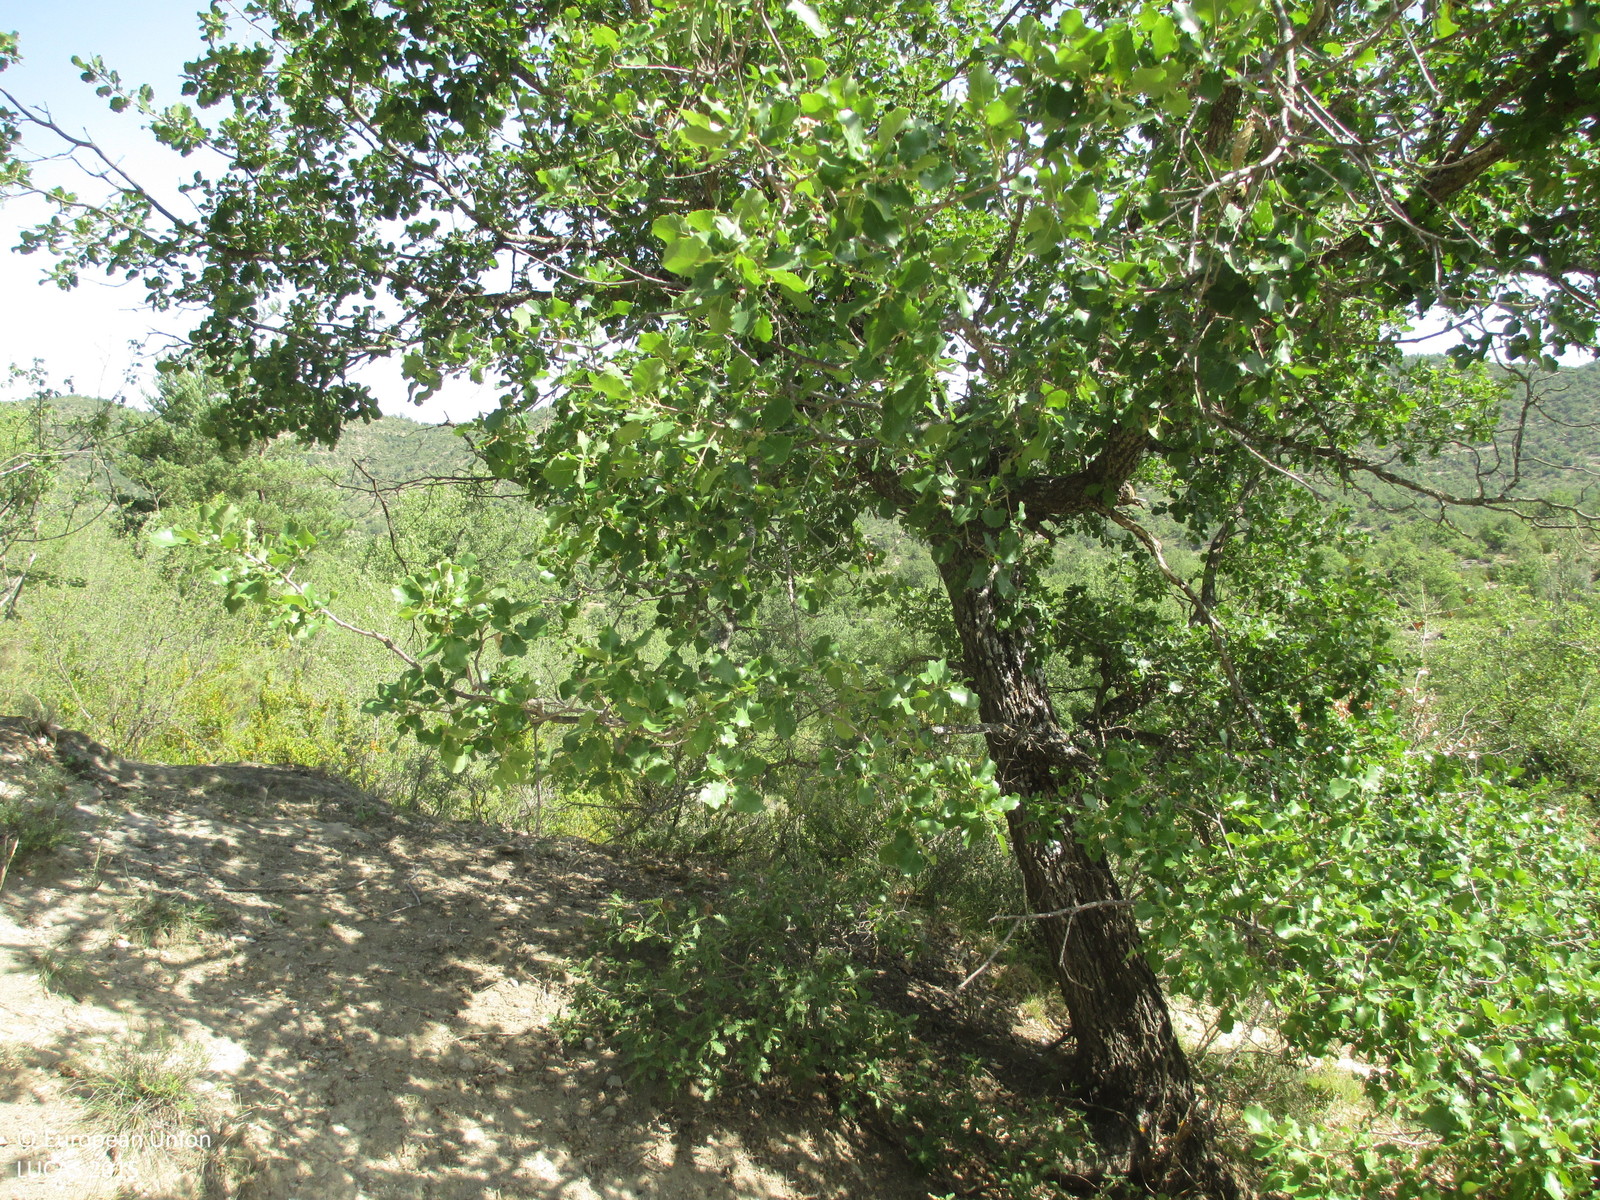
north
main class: Grassland
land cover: Grassland with sparse tree/shrub cover
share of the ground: > 75 %
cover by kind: herbaceous plants 85 %, coniferous forest trees 5 %, shrubs 5 %, consolidated bare surface 5 %
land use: Semi-natural and natural areas not in use
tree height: > 5 m
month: July
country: ES
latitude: 42.3712
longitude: -0.4073
